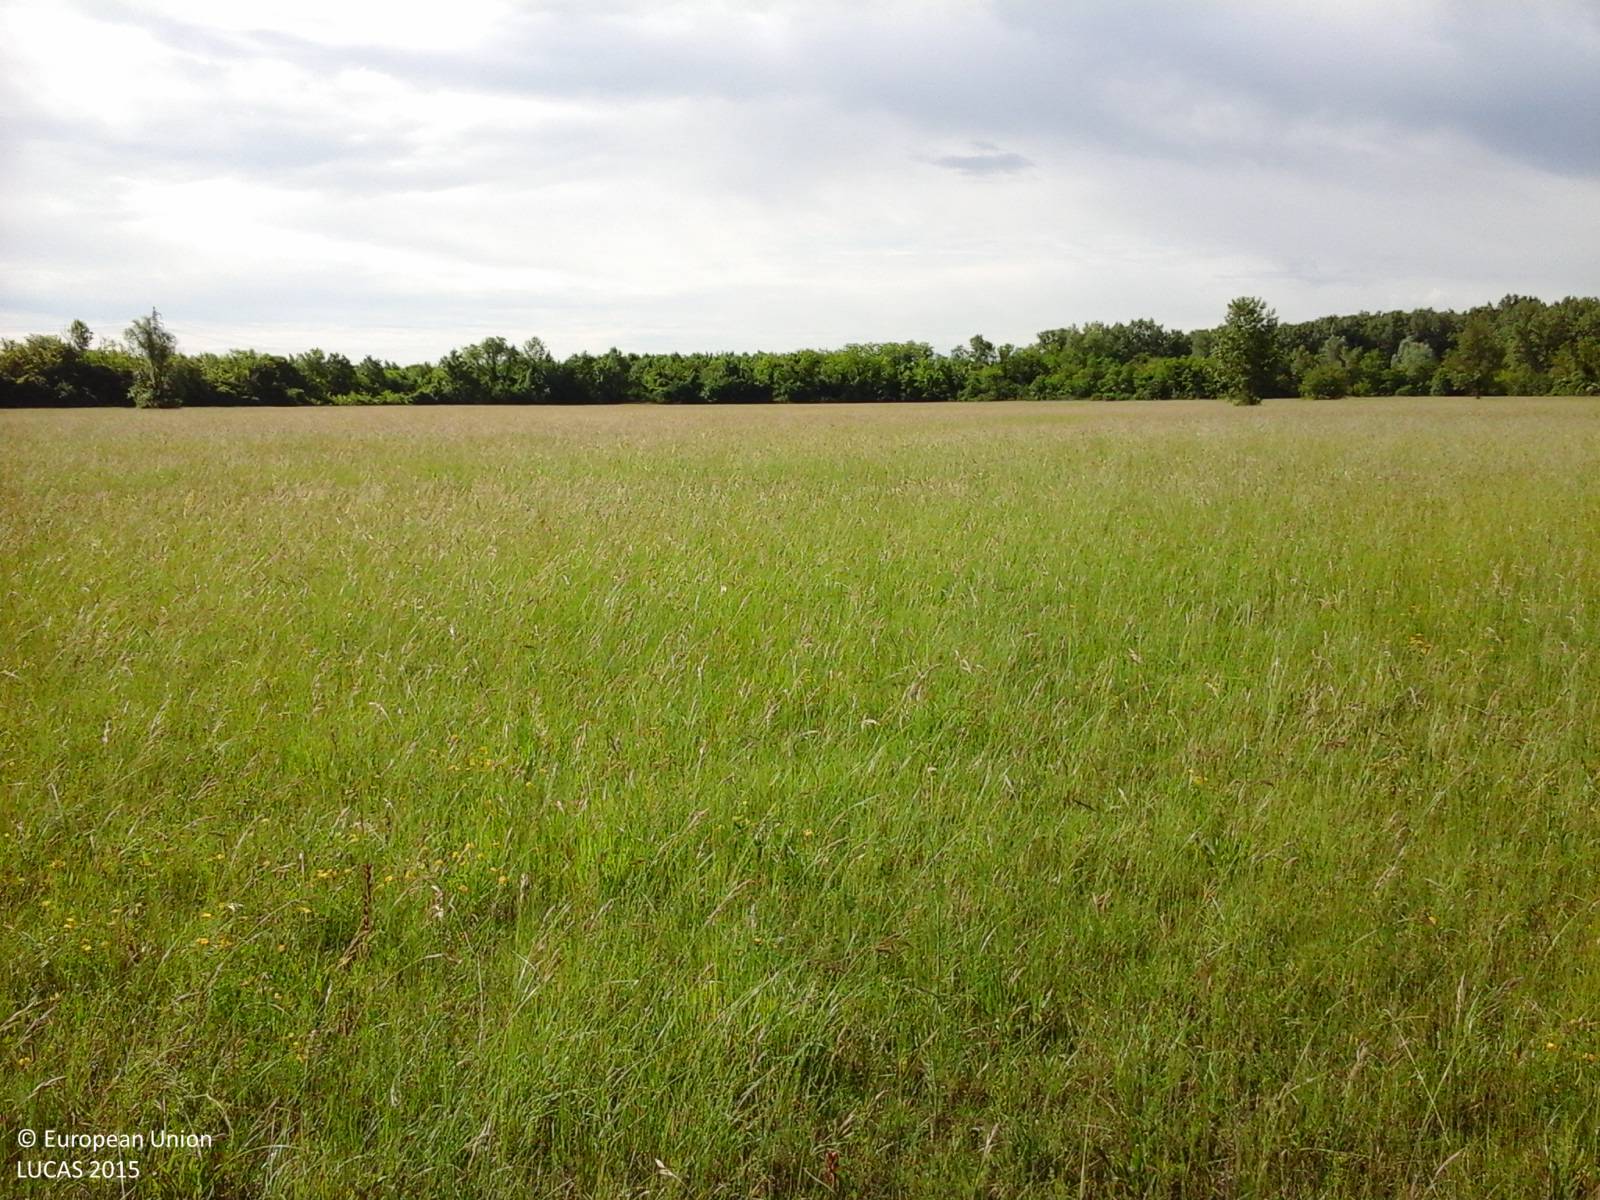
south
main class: Grassland
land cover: Grassland without tree/shrub cover
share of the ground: > 75 %
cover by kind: herbaceous plants 100 %
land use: Agriculture (excluding fallow land and kitchen gardens)
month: May
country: IT
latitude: 46.0474
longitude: 13.3177
